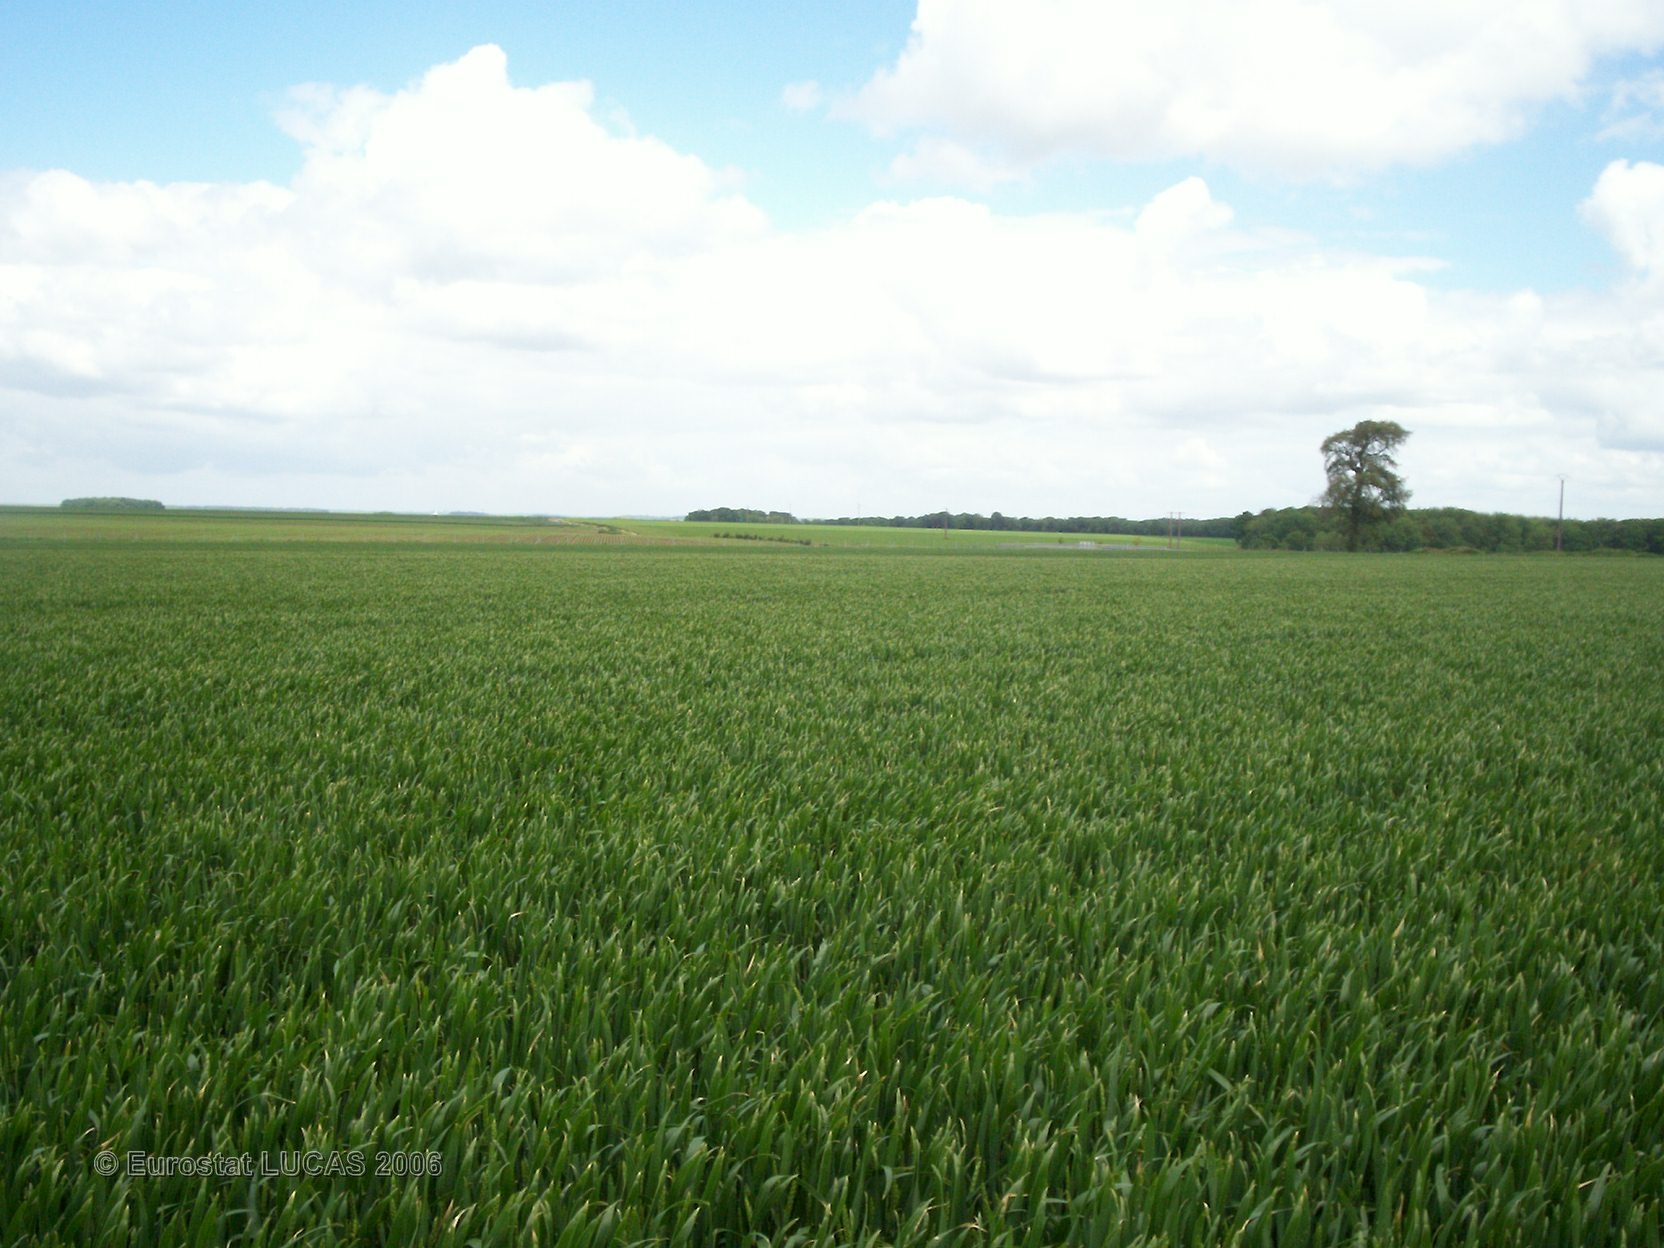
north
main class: Cropland
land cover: Common wheat
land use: Agriculture (excluding fallow land and kitchen gardens)
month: May
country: FR
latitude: 49.8571
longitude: 2.6581
